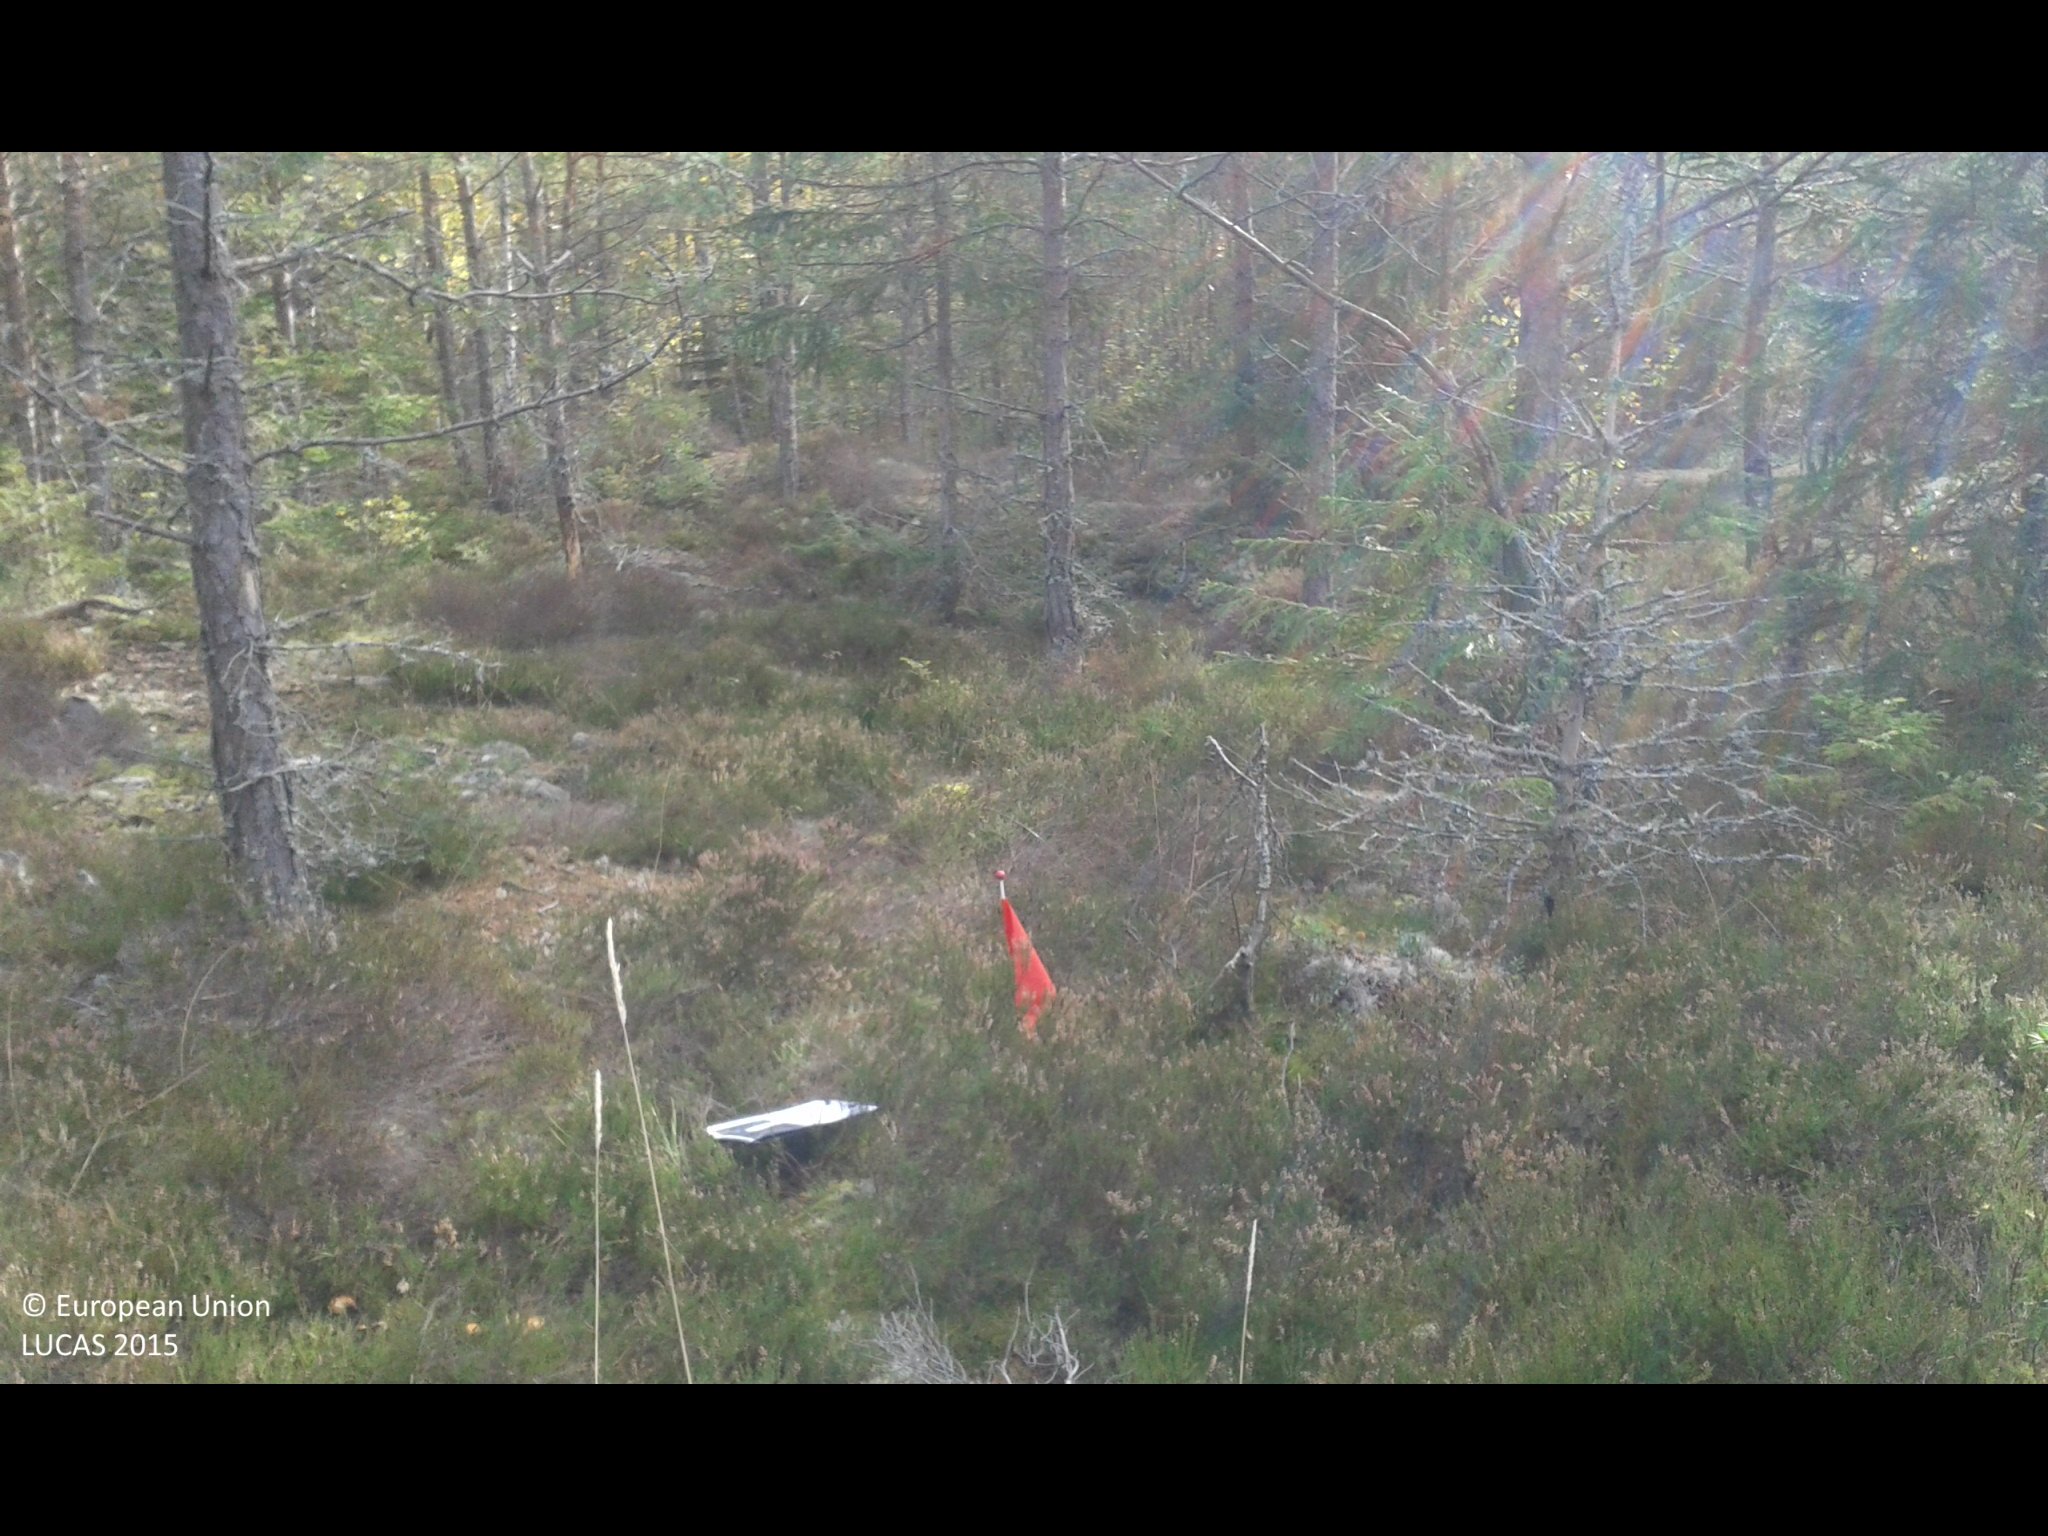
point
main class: Woodland
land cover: Pine dominated coniferous woodland
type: boreal forest
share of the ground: > 75 %
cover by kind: coniferous forest trees 75 %, herbaceous plants 15 %, broadleaved forest trees 10 %
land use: Forestry
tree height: > 5 m
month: September
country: SE
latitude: 59.0832
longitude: 17.3779
